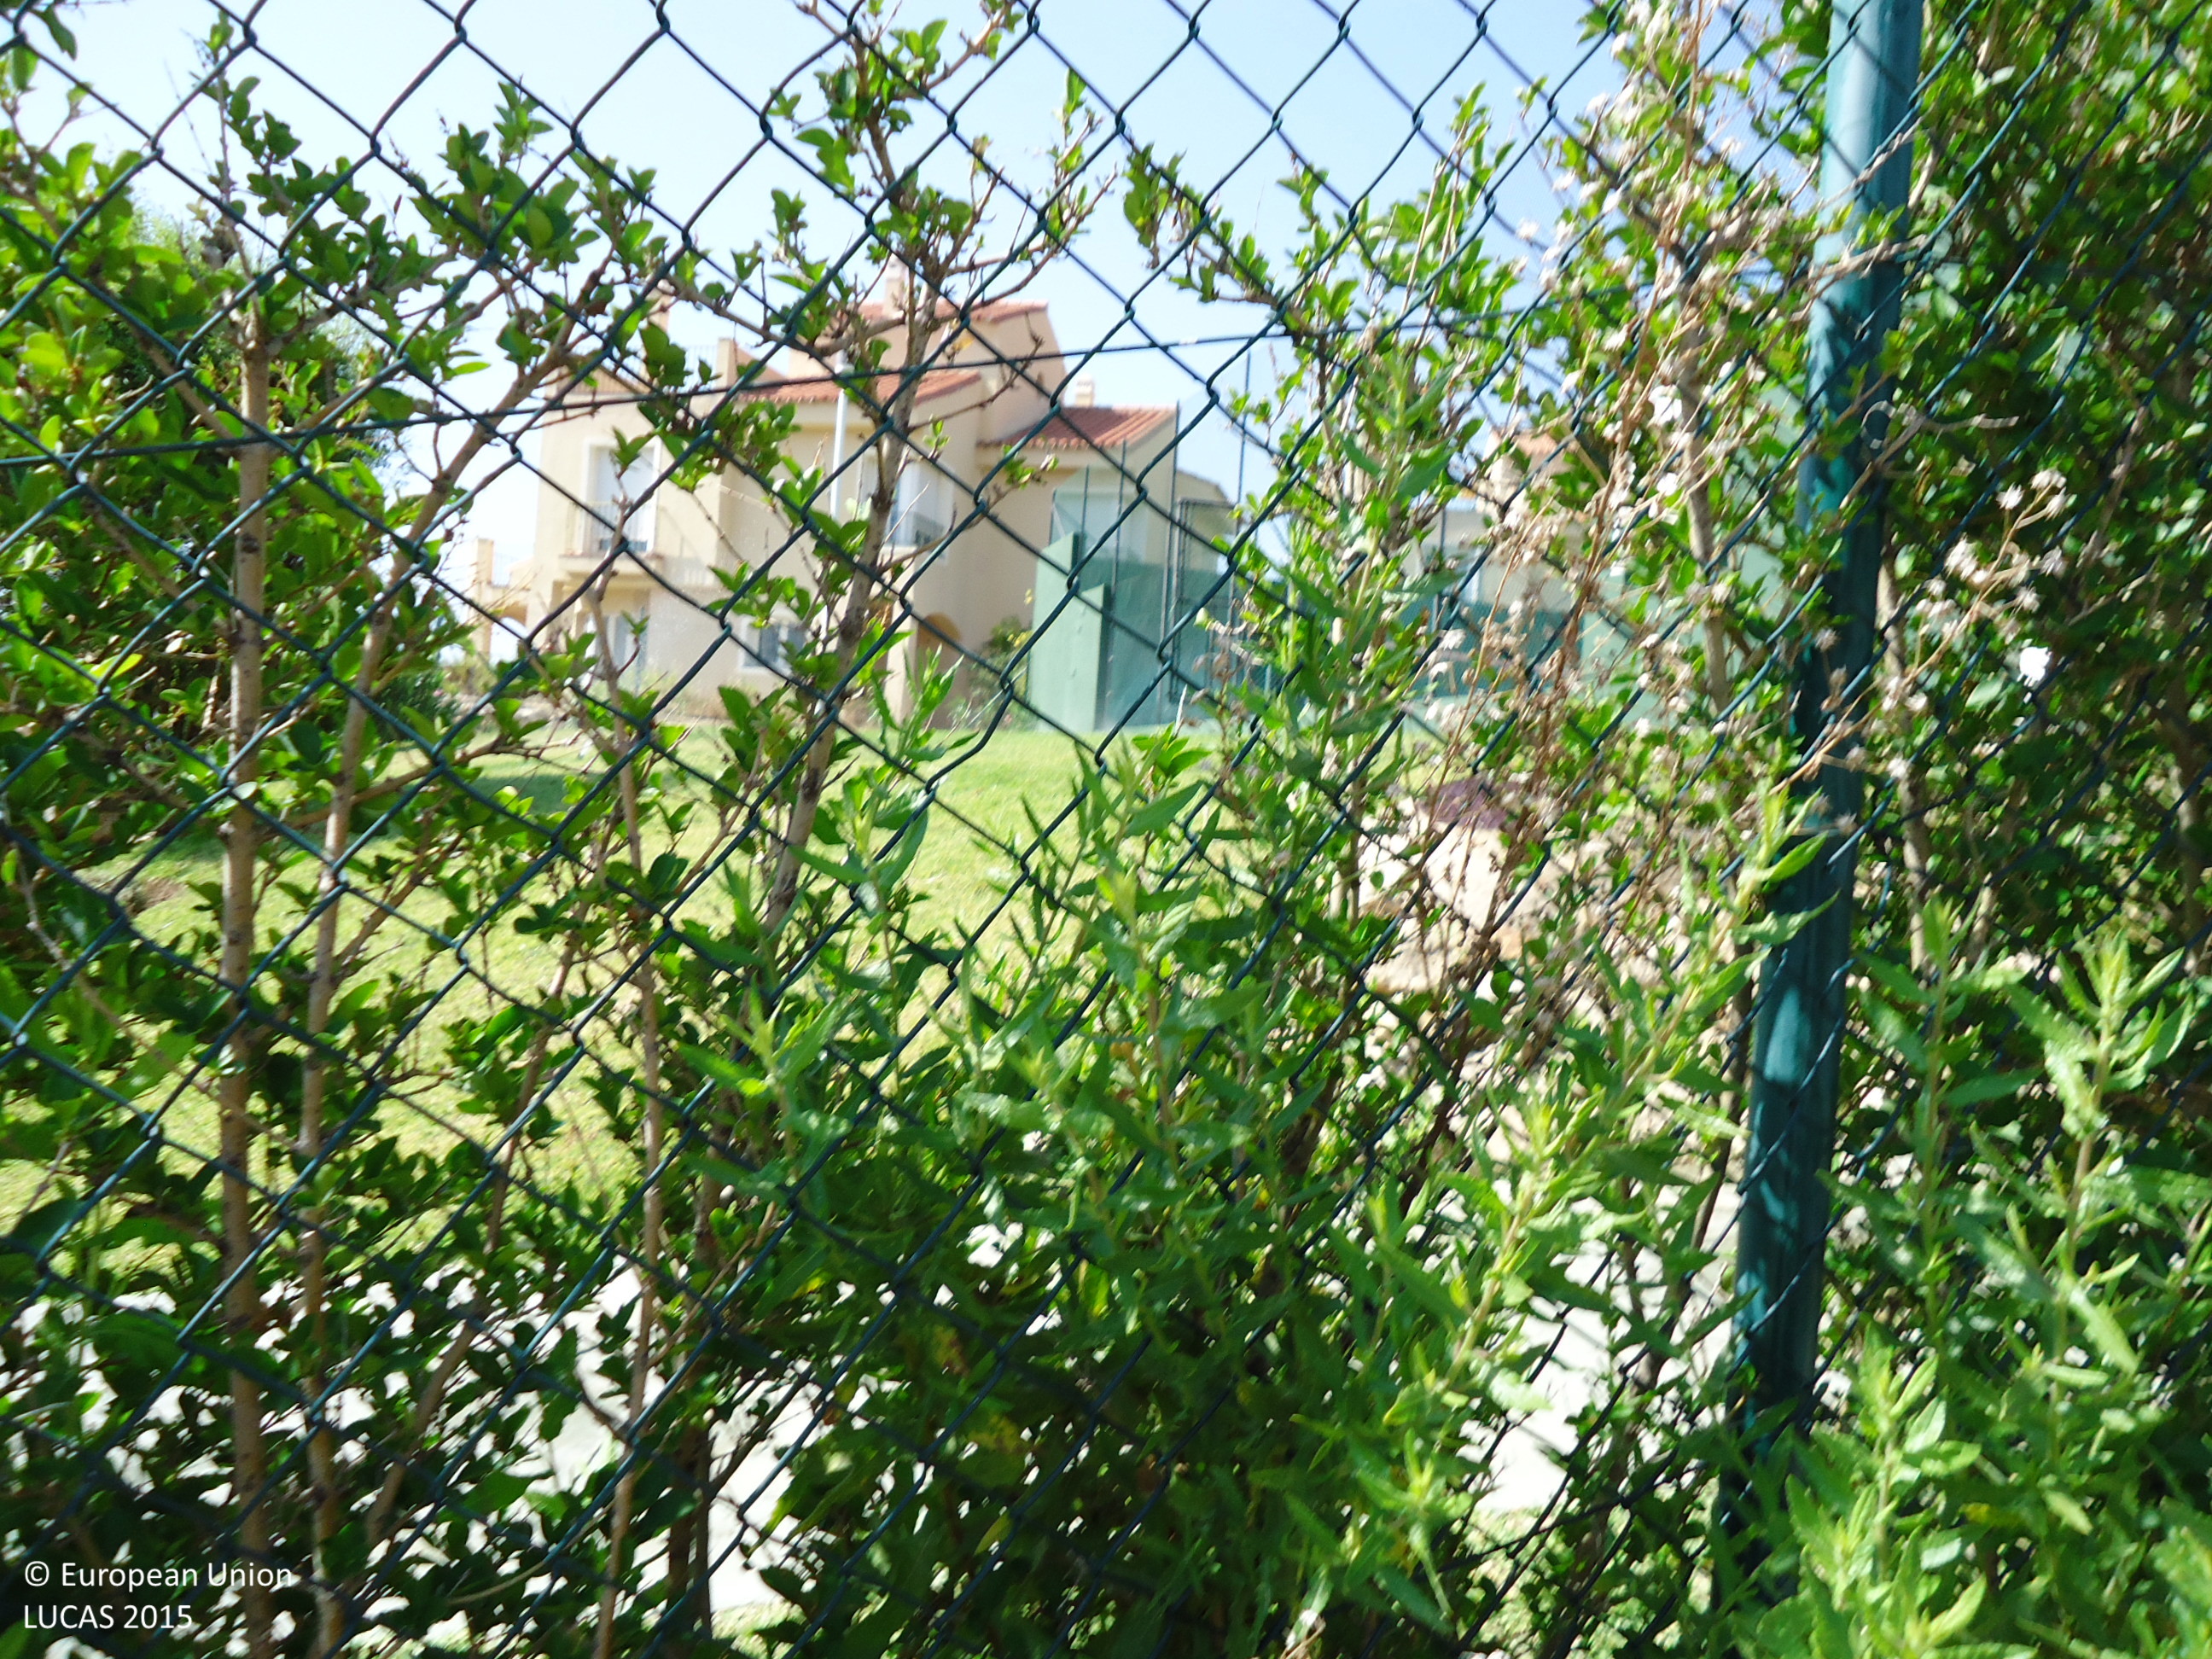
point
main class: Grassland
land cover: Grassland with sparse tree/shrub cover
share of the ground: > 75 %
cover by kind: herbaceous plants 95 %, broadleaved forest trees 5 %
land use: Residential
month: July
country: ES
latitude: 36.5039
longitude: -4.7157
